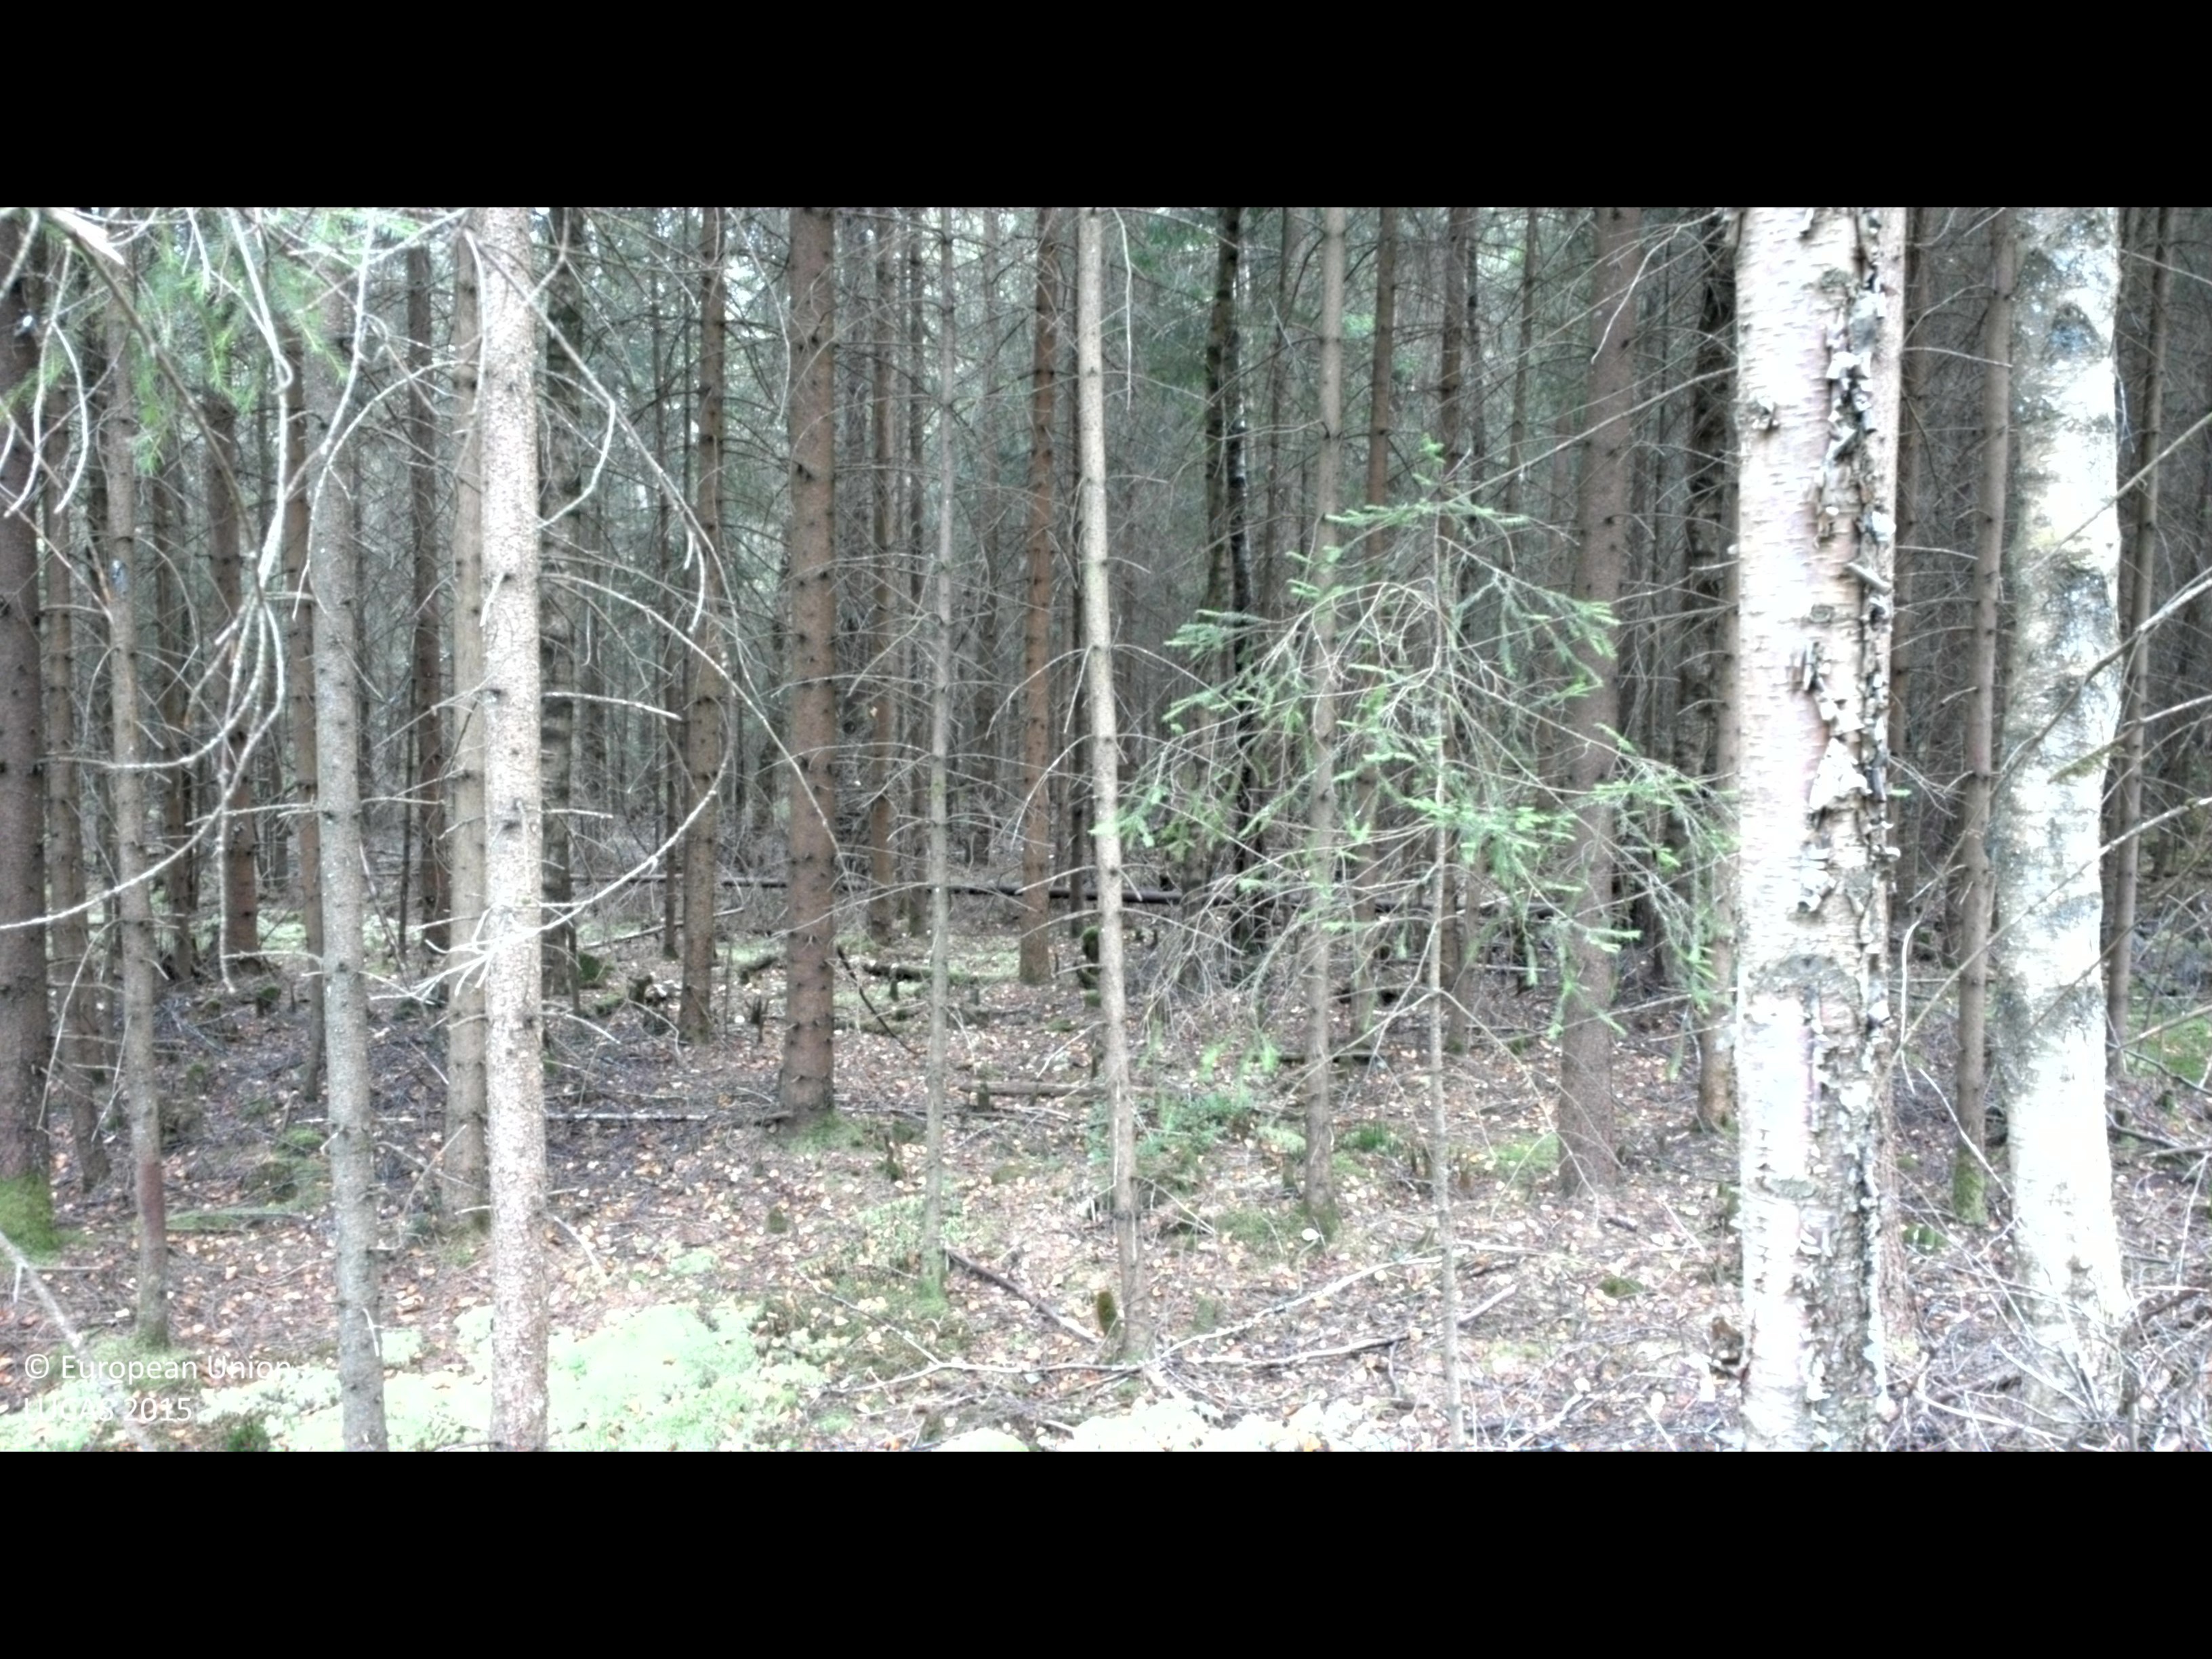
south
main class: Woodland
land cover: Spruce dominated coniferous woodland
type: boreal forest
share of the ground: > 75 %
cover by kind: coniferous forest trees 70 %, lichens and mosses 25 %, broadleaved forest trees 5 %
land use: Forestry
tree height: > 5 m
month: August
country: SE
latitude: 56.8318
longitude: 13.1924
